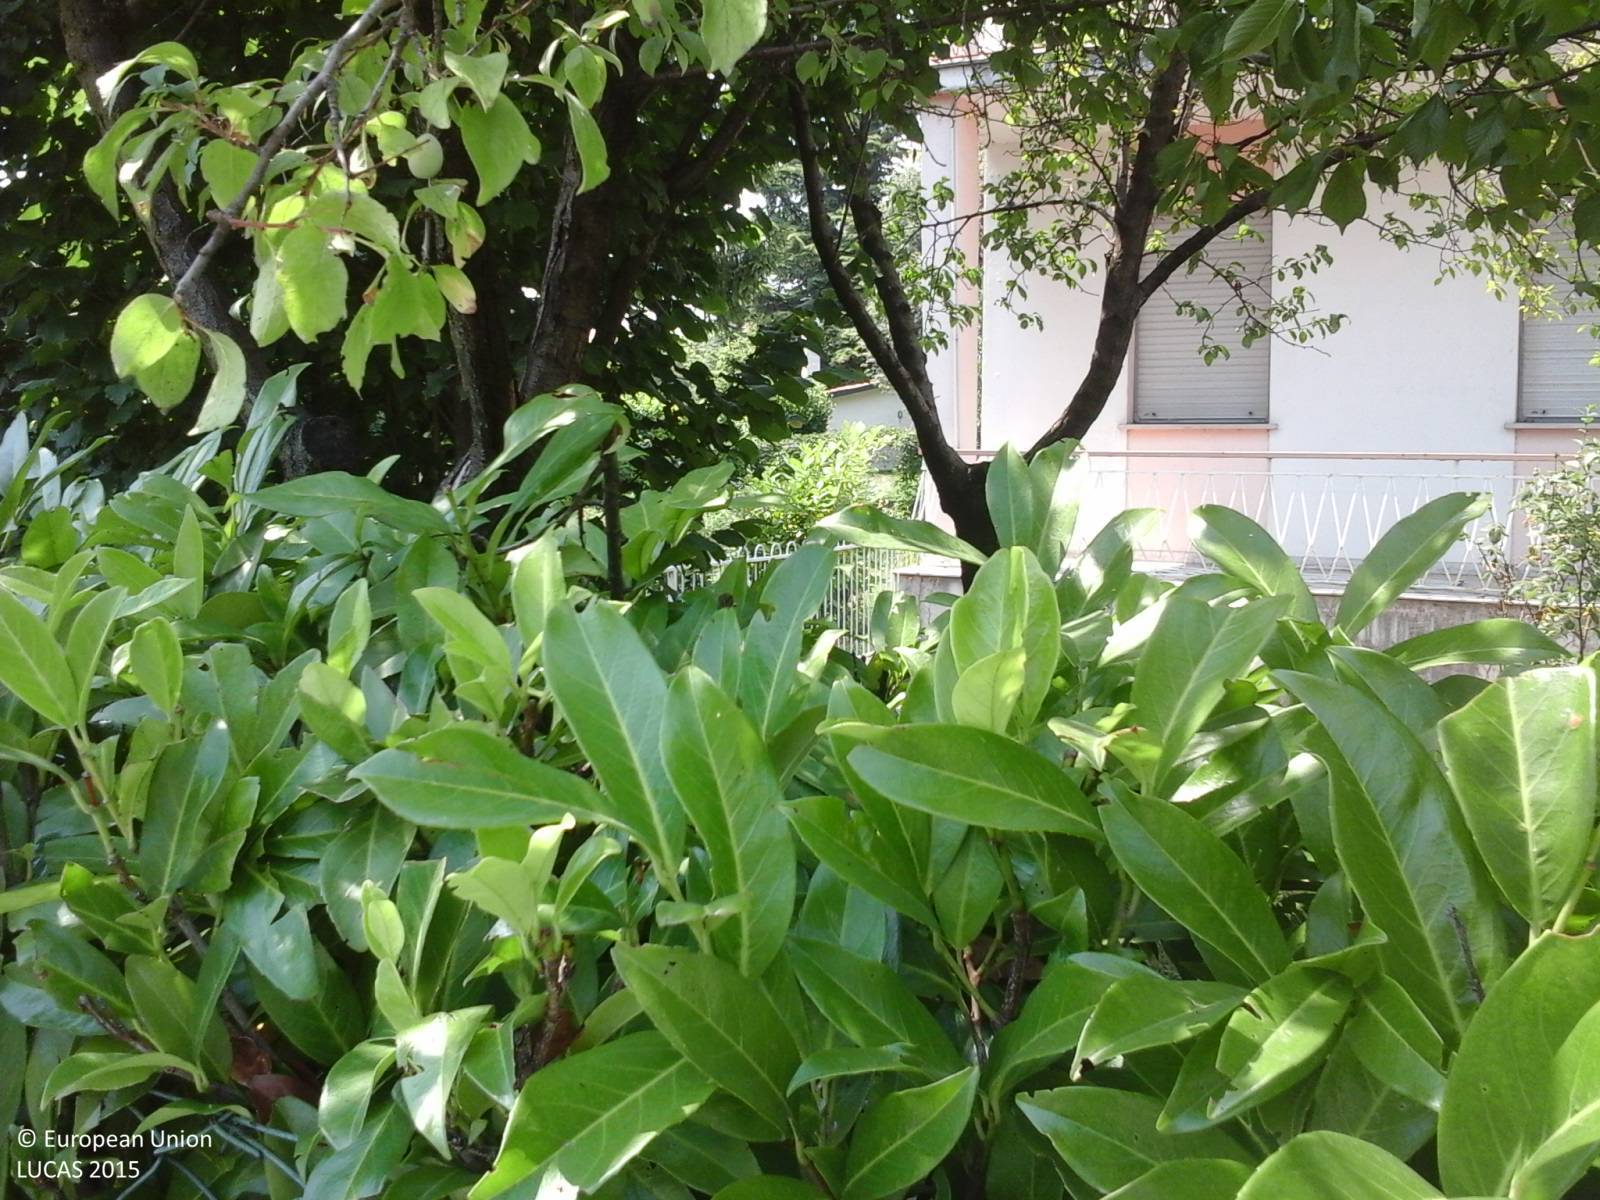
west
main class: Grassland
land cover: Grassland with sparse tree/shrub cover
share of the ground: > 75 %
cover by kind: herbaceous plants 95 %, broadleaved forest trees 5 %
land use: Residential
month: July
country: IT
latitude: 45.9581
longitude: 12.6417
